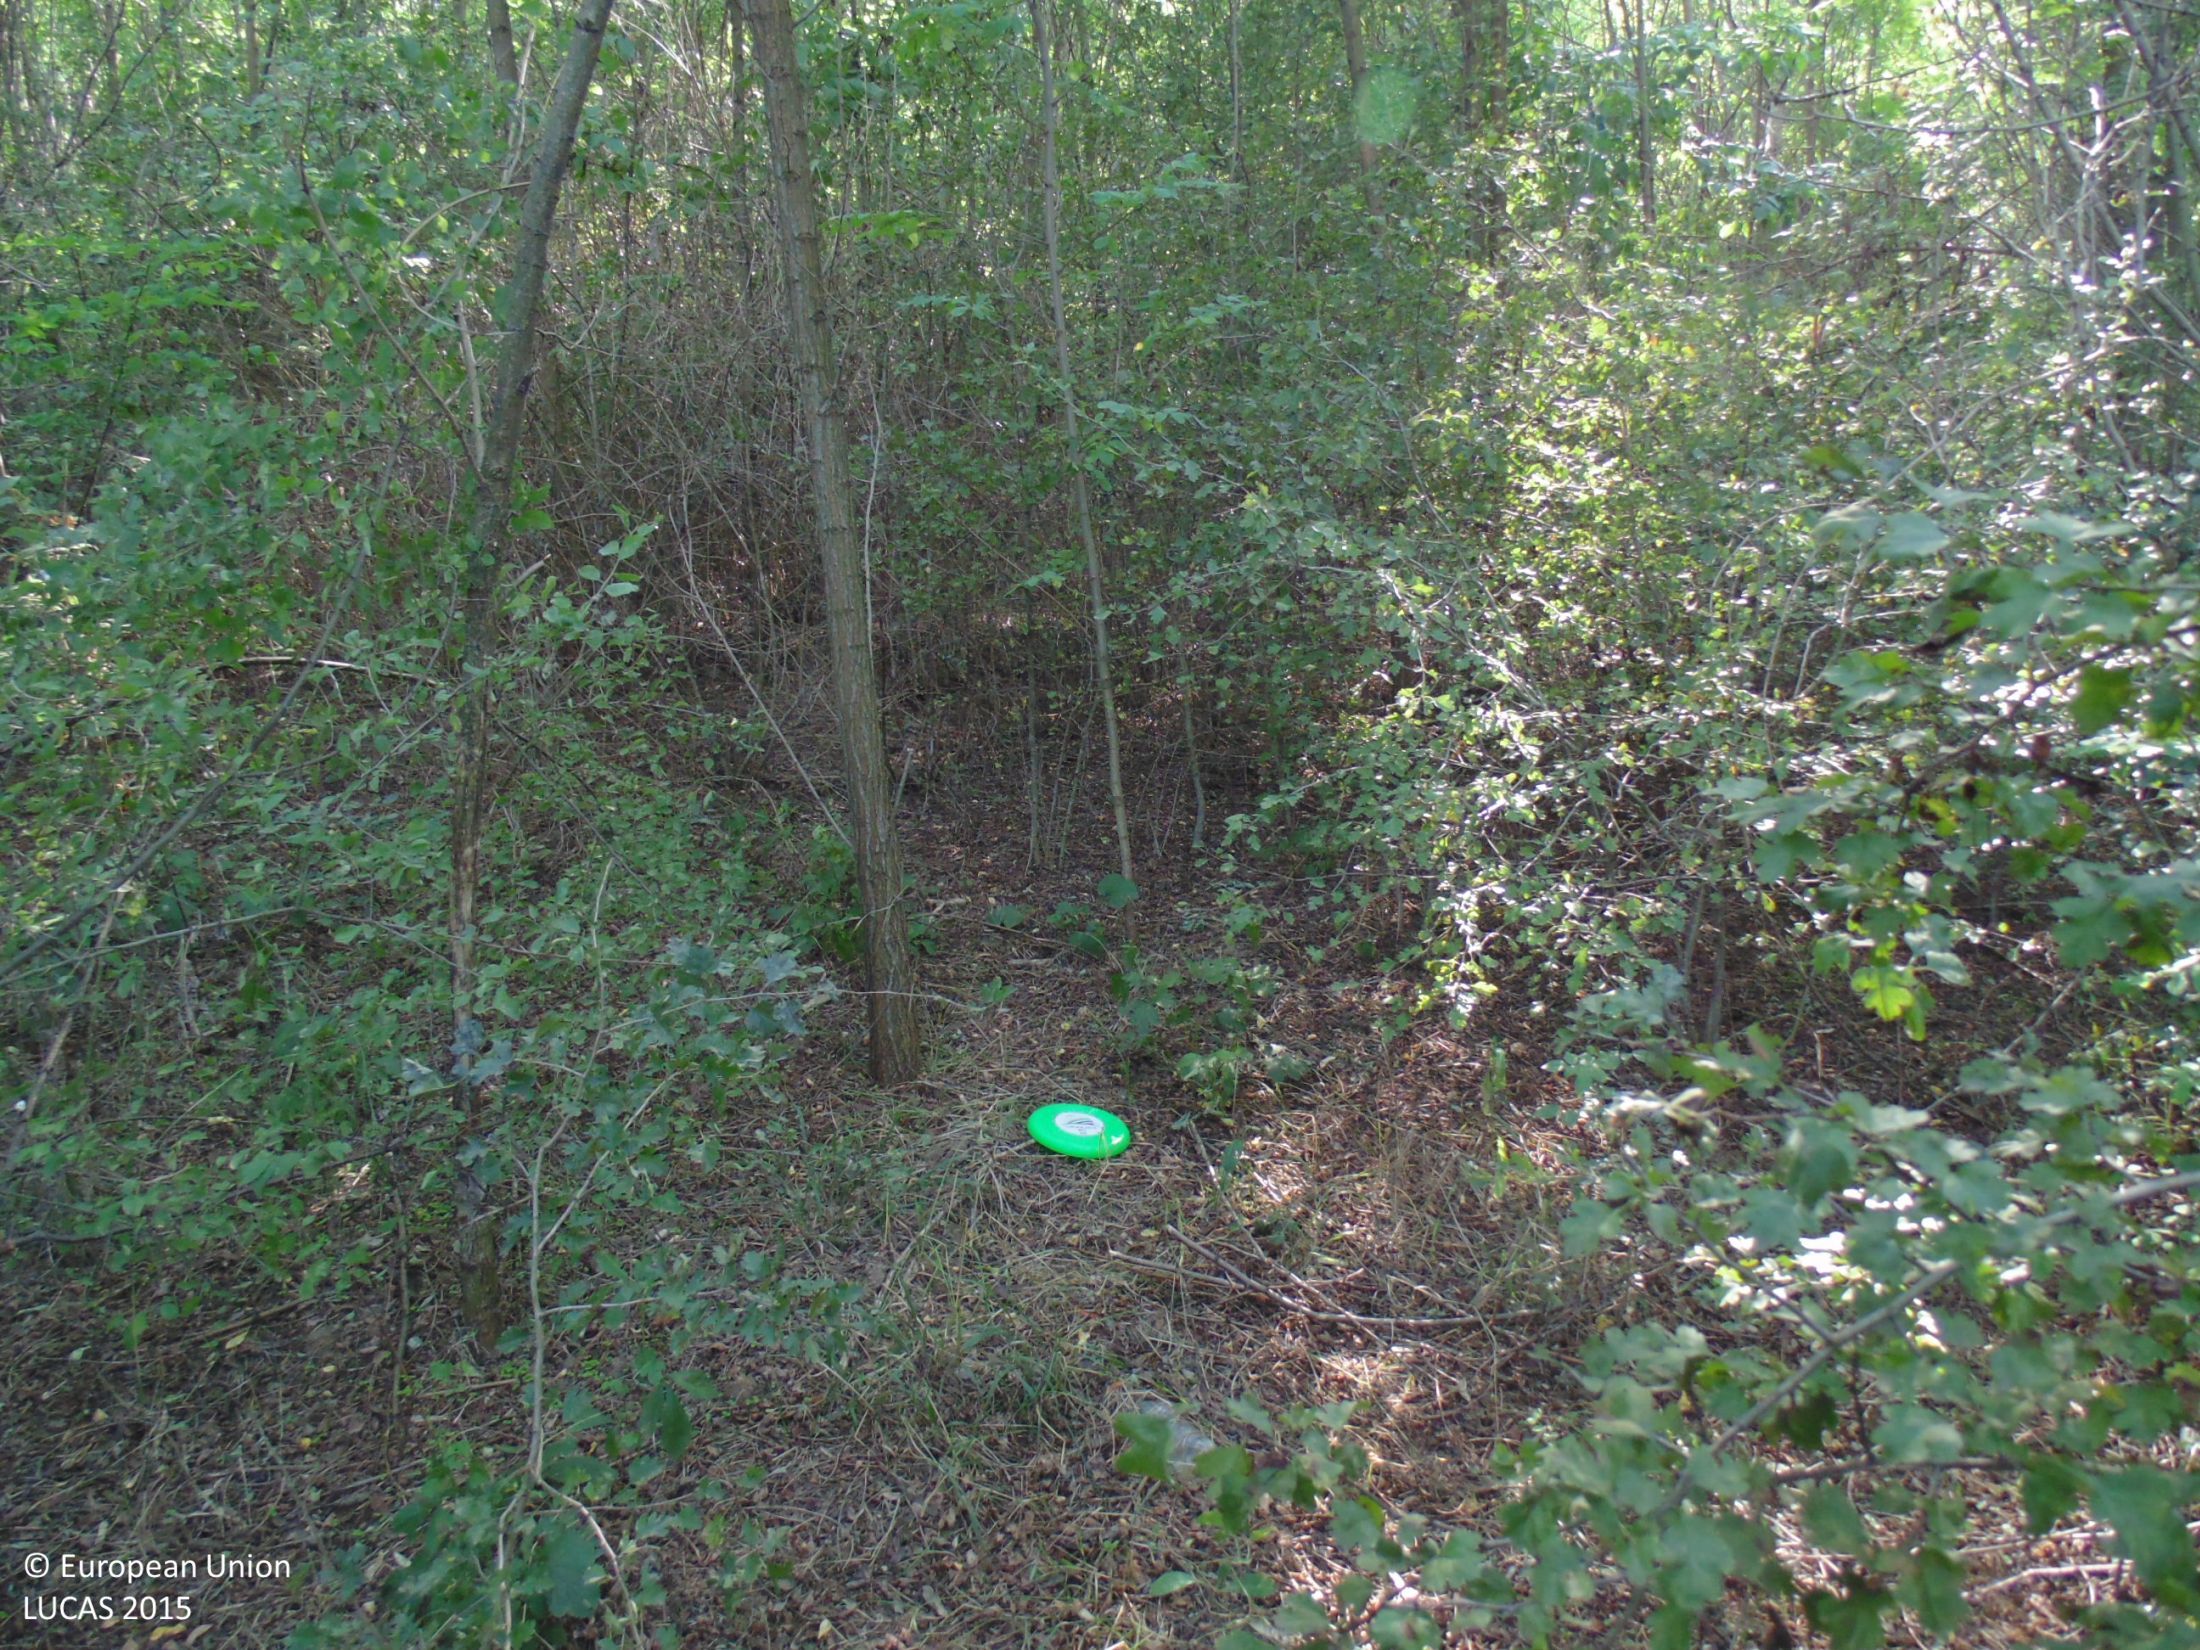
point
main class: Woodland
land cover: Broadleaved woodland
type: mesophytic deciduous forest
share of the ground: > 75 %
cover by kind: broadleaved forest trees 90 %, shrubs 5 %, unconsolidated bare surface 5 %
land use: Forestry
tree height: > 5 m
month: August
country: BG
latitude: 43.9238
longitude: 27.3574
